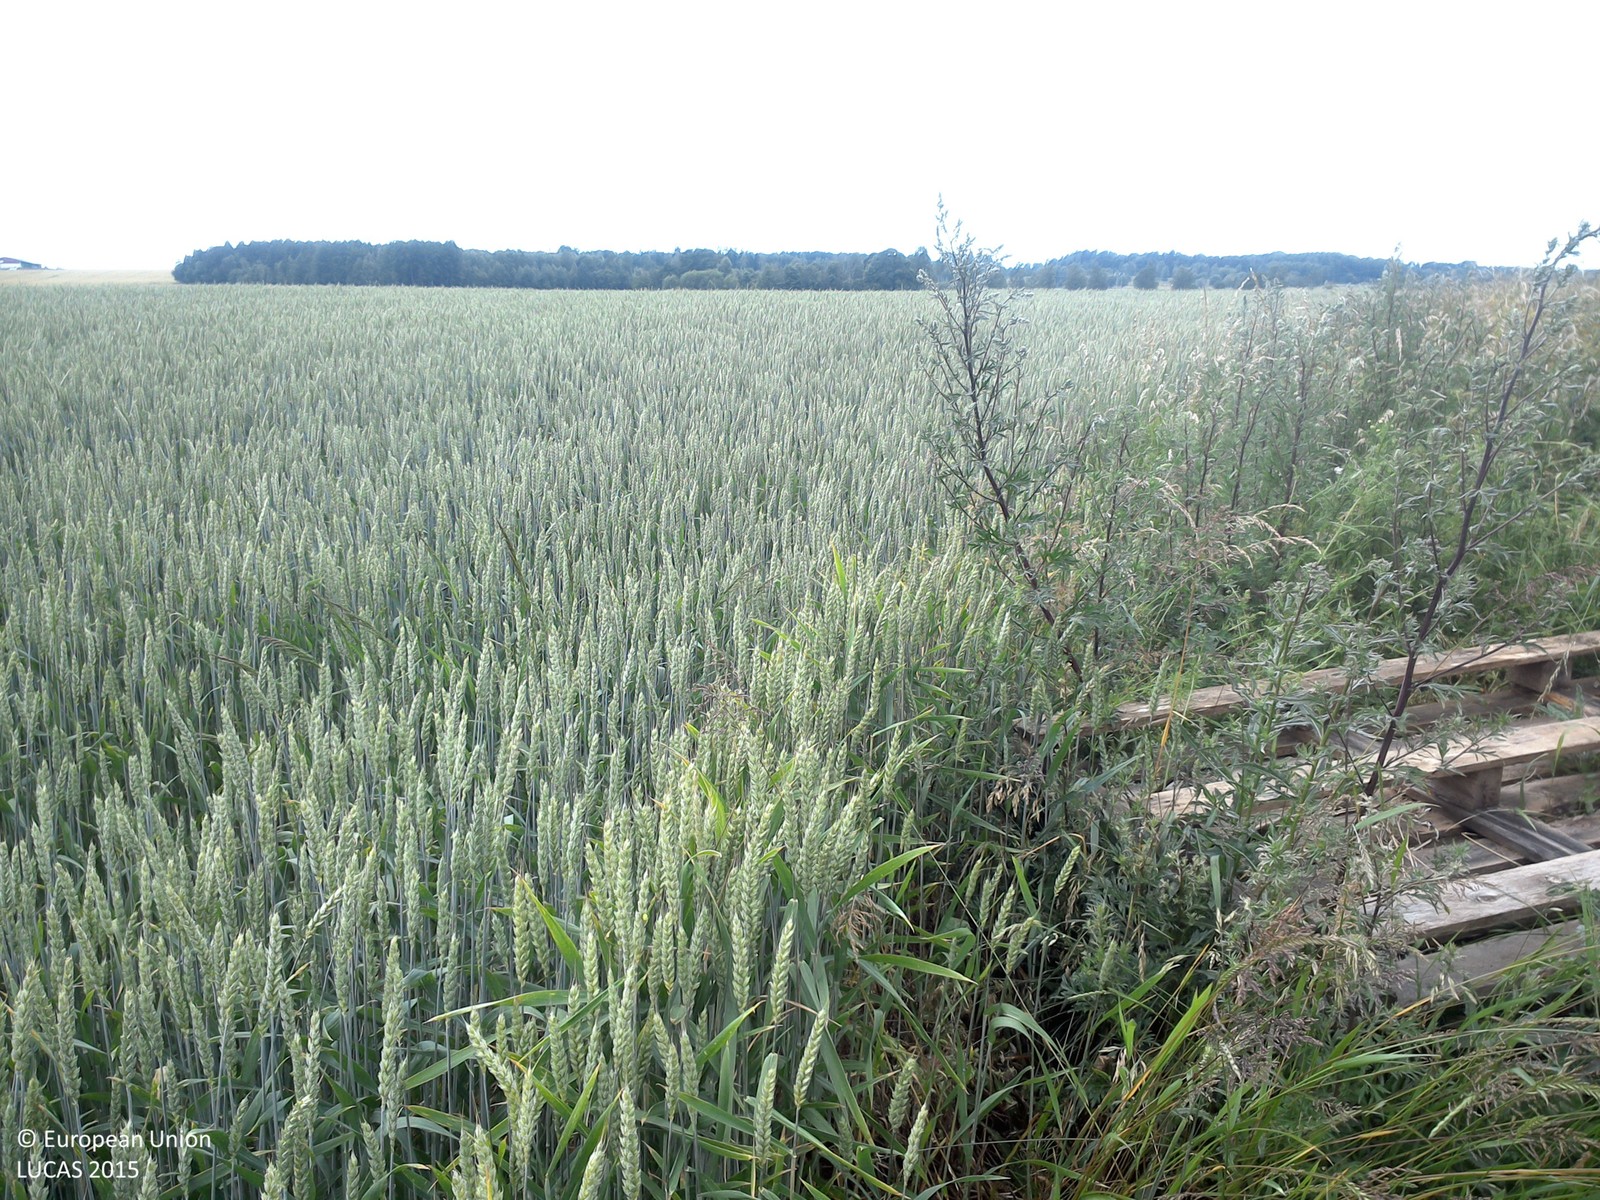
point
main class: Cropland
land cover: Common wheat
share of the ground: > 75 %
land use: Agriculture (excluding fallow land and kitchen gardens)
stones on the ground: < 10 %
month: July
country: SE
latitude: 58.5018
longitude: 15.0903
